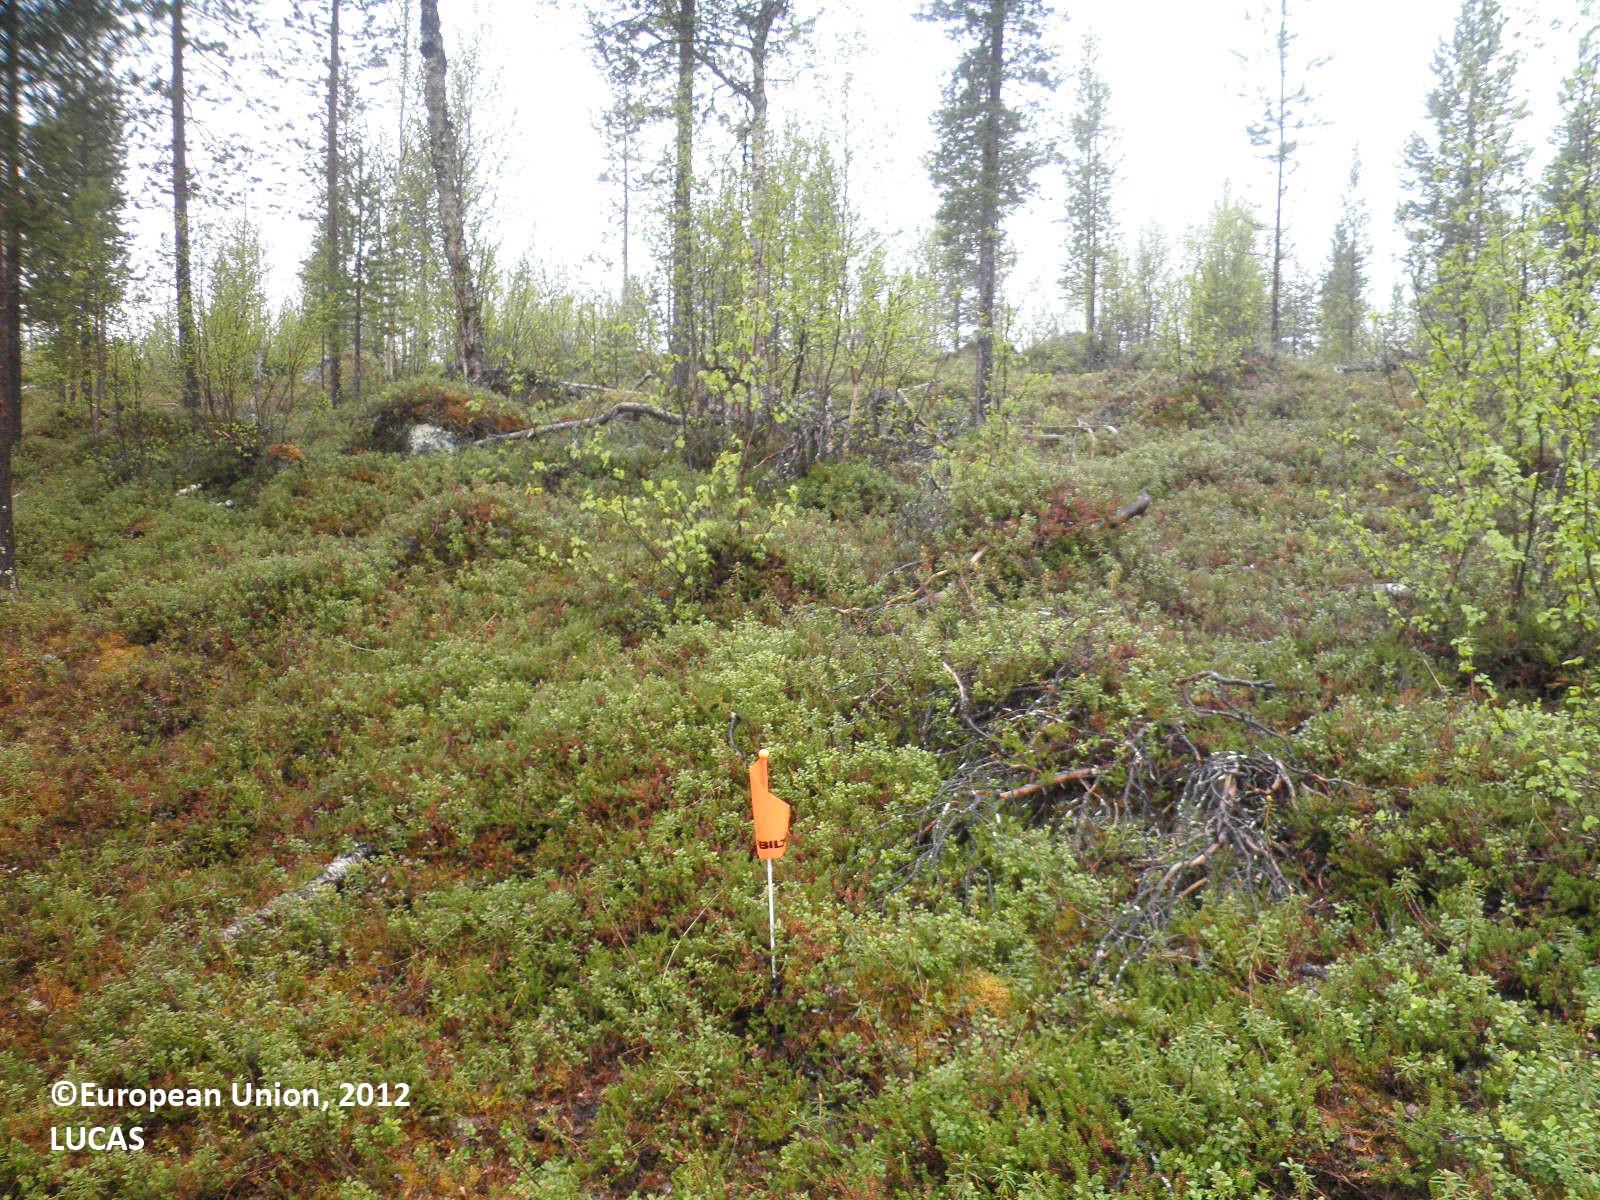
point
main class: Woodland
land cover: Pine dominated mixed woodland
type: boreal forest
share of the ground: 25 - 50 %
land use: Forestry
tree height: > 5 m
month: June
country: FI
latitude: 68.8759
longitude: 26.7879
